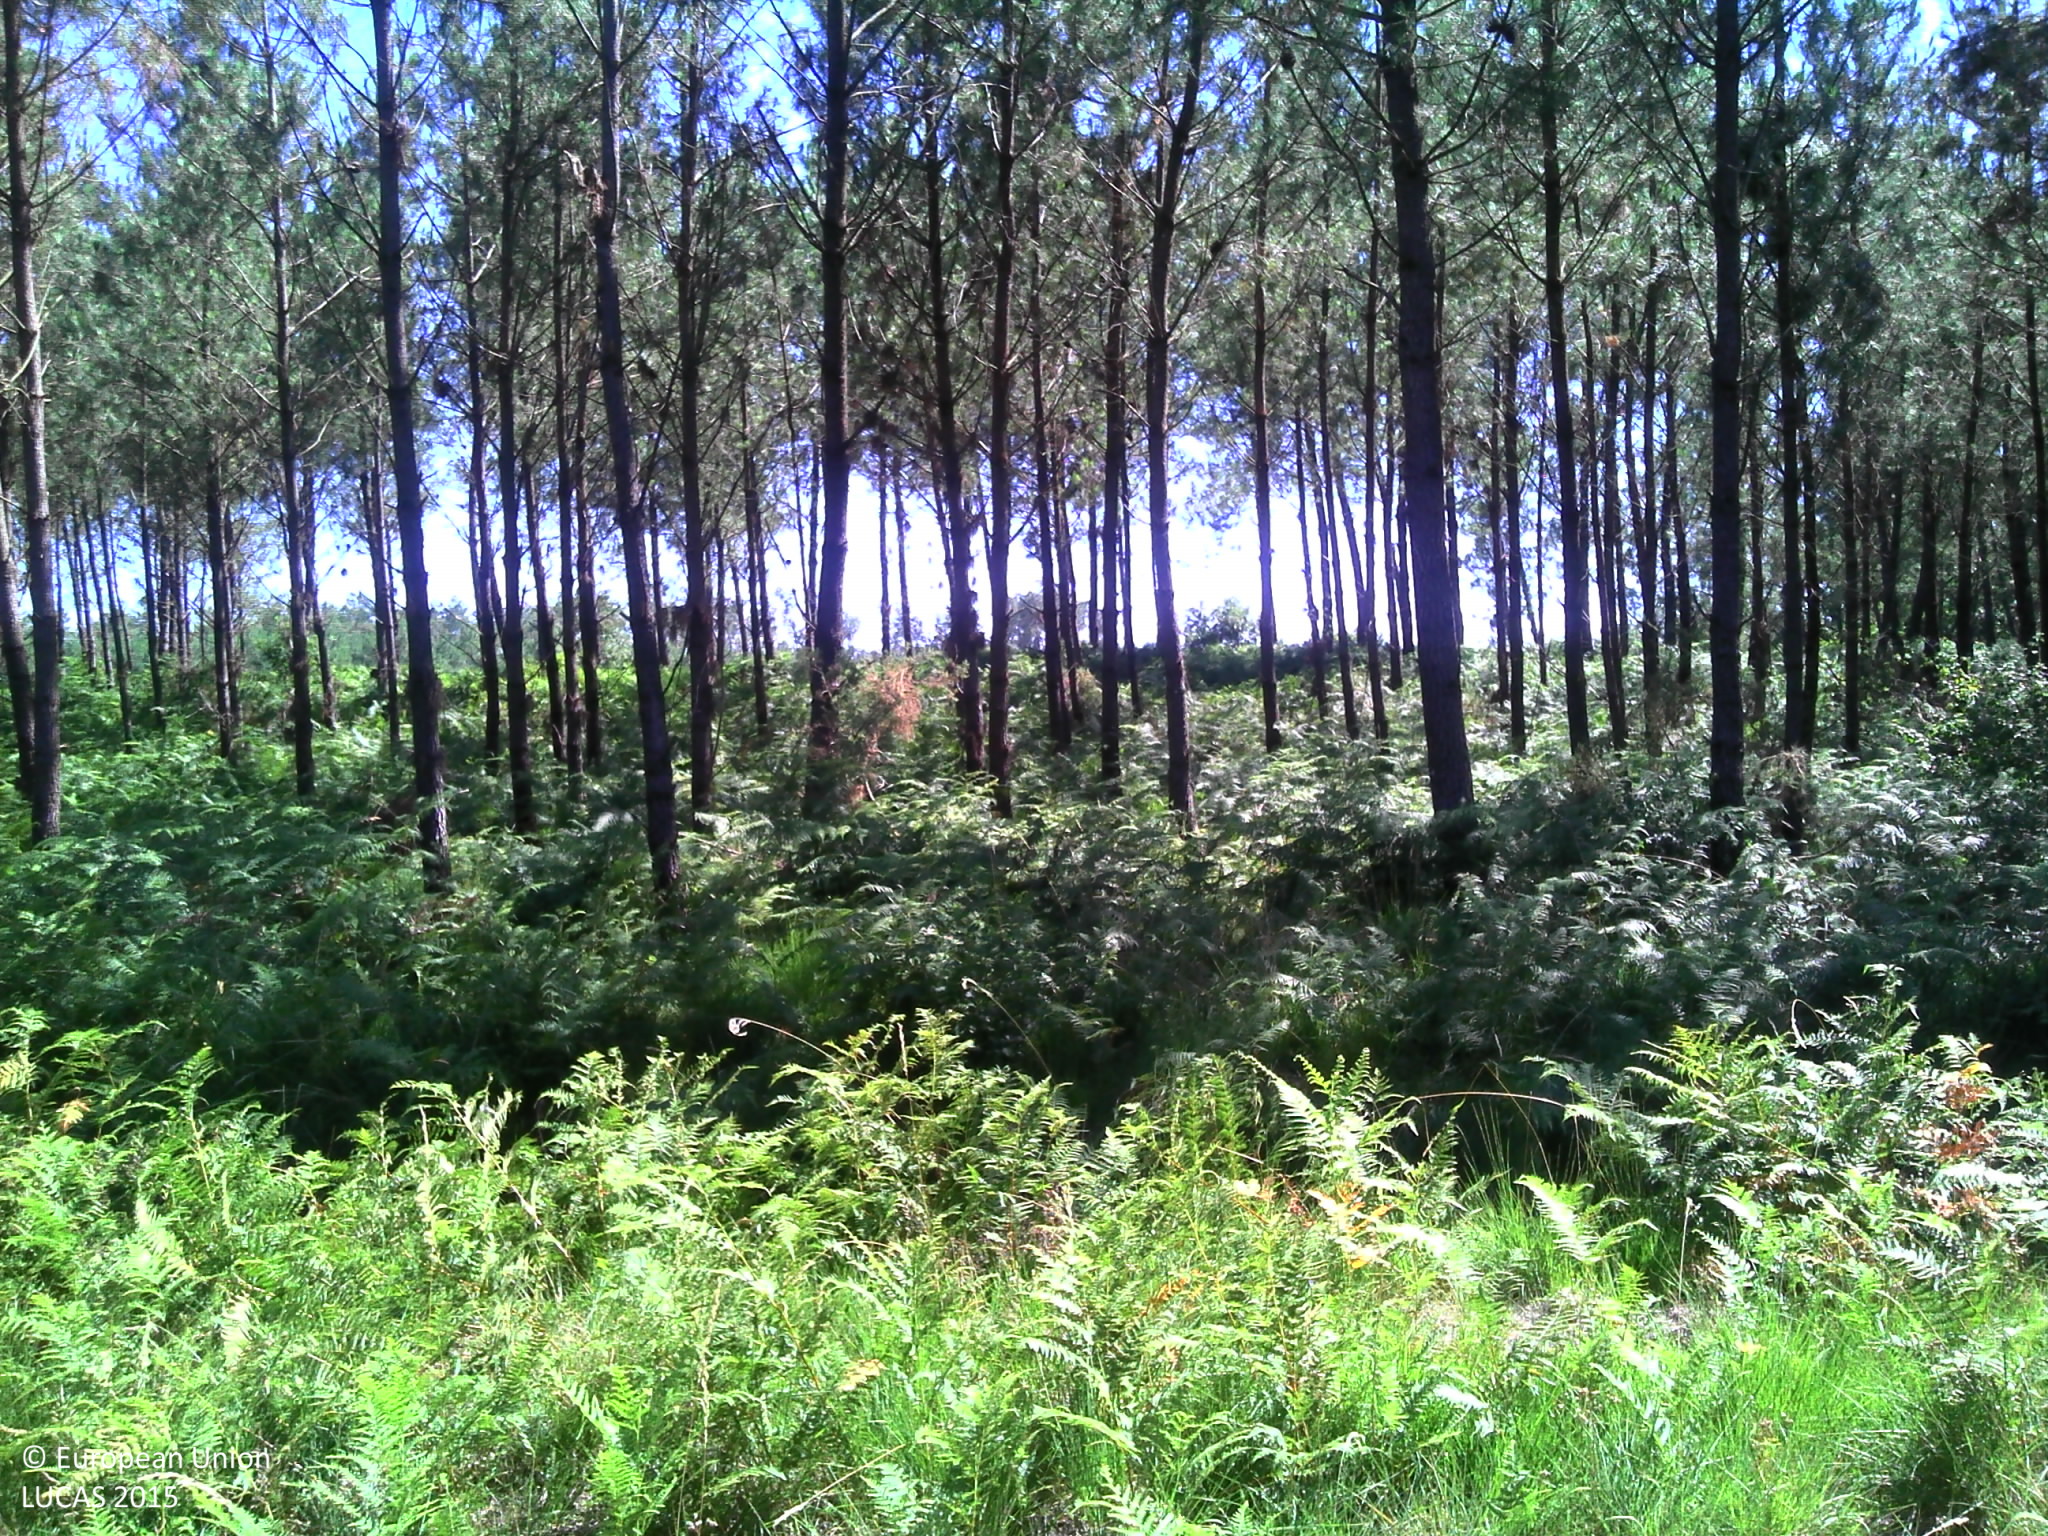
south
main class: Woodland
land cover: Pine dominated coniferous woodland
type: coniferous forest of the mediterranean region
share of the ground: > 75 %
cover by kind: coniferous forest trees 85 %, herbaceous plants 10 %, shrubs 5 %
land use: Forestry
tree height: > 5 m
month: July
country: FR
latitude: 43.9956
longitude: -0.5250
